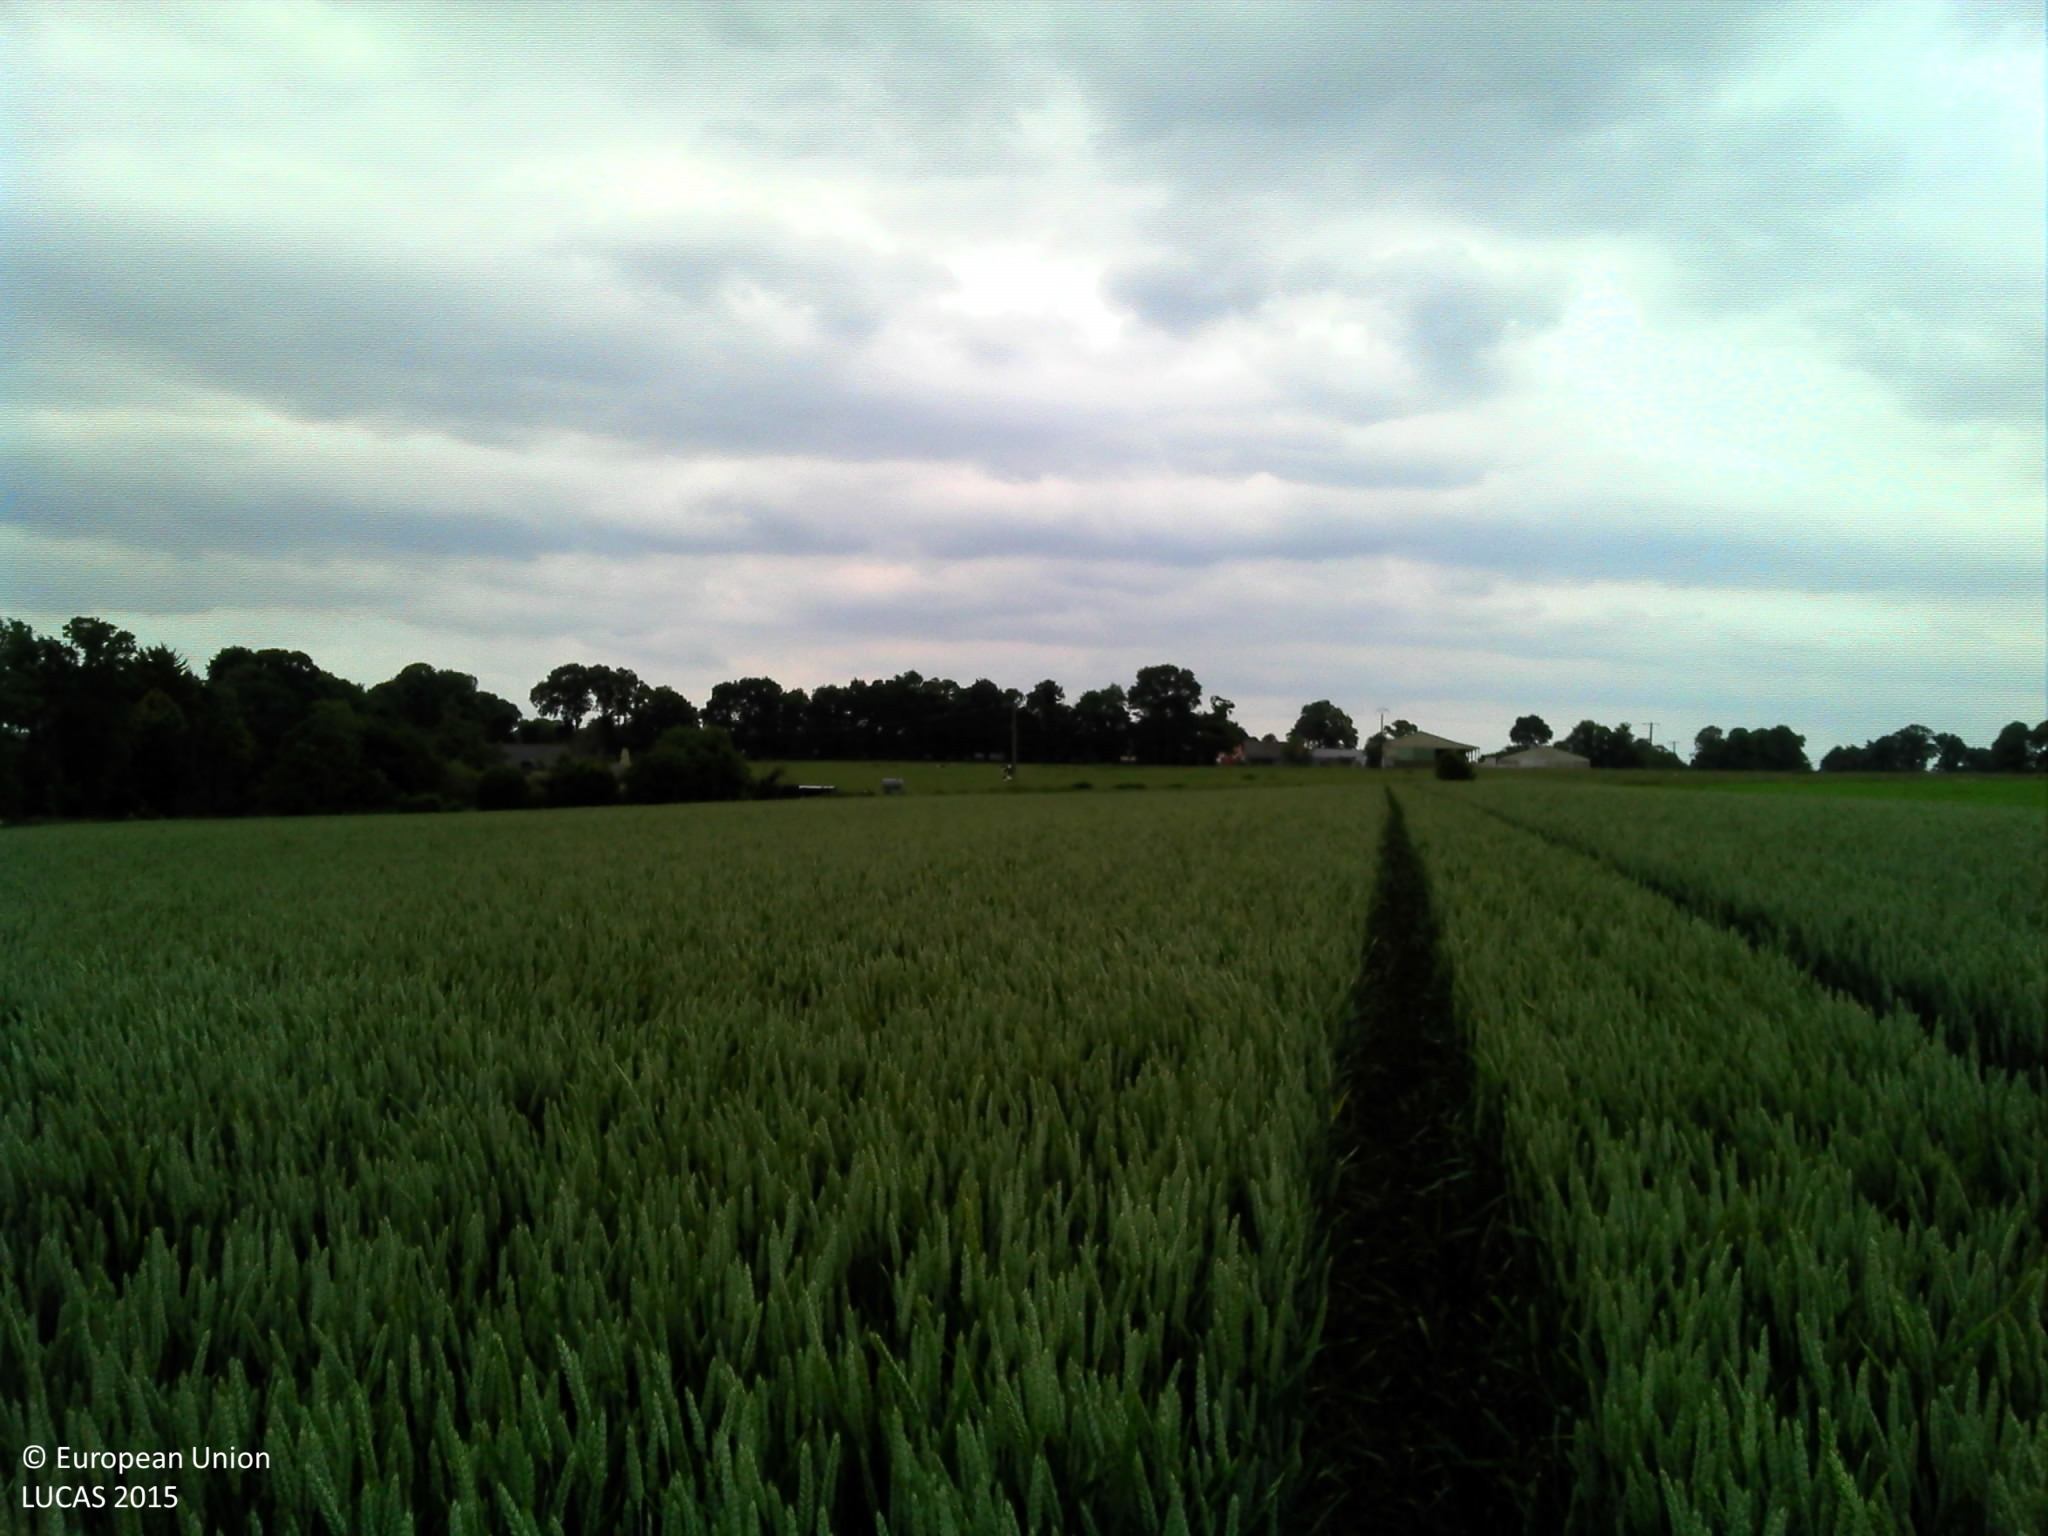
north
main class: Cropland
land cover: Common wheat
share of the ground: > 75 %
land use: Agriculture (excluding fallow land and kitchen gardens)
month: June
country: FR
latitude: 48.2023
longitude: -1.6599
